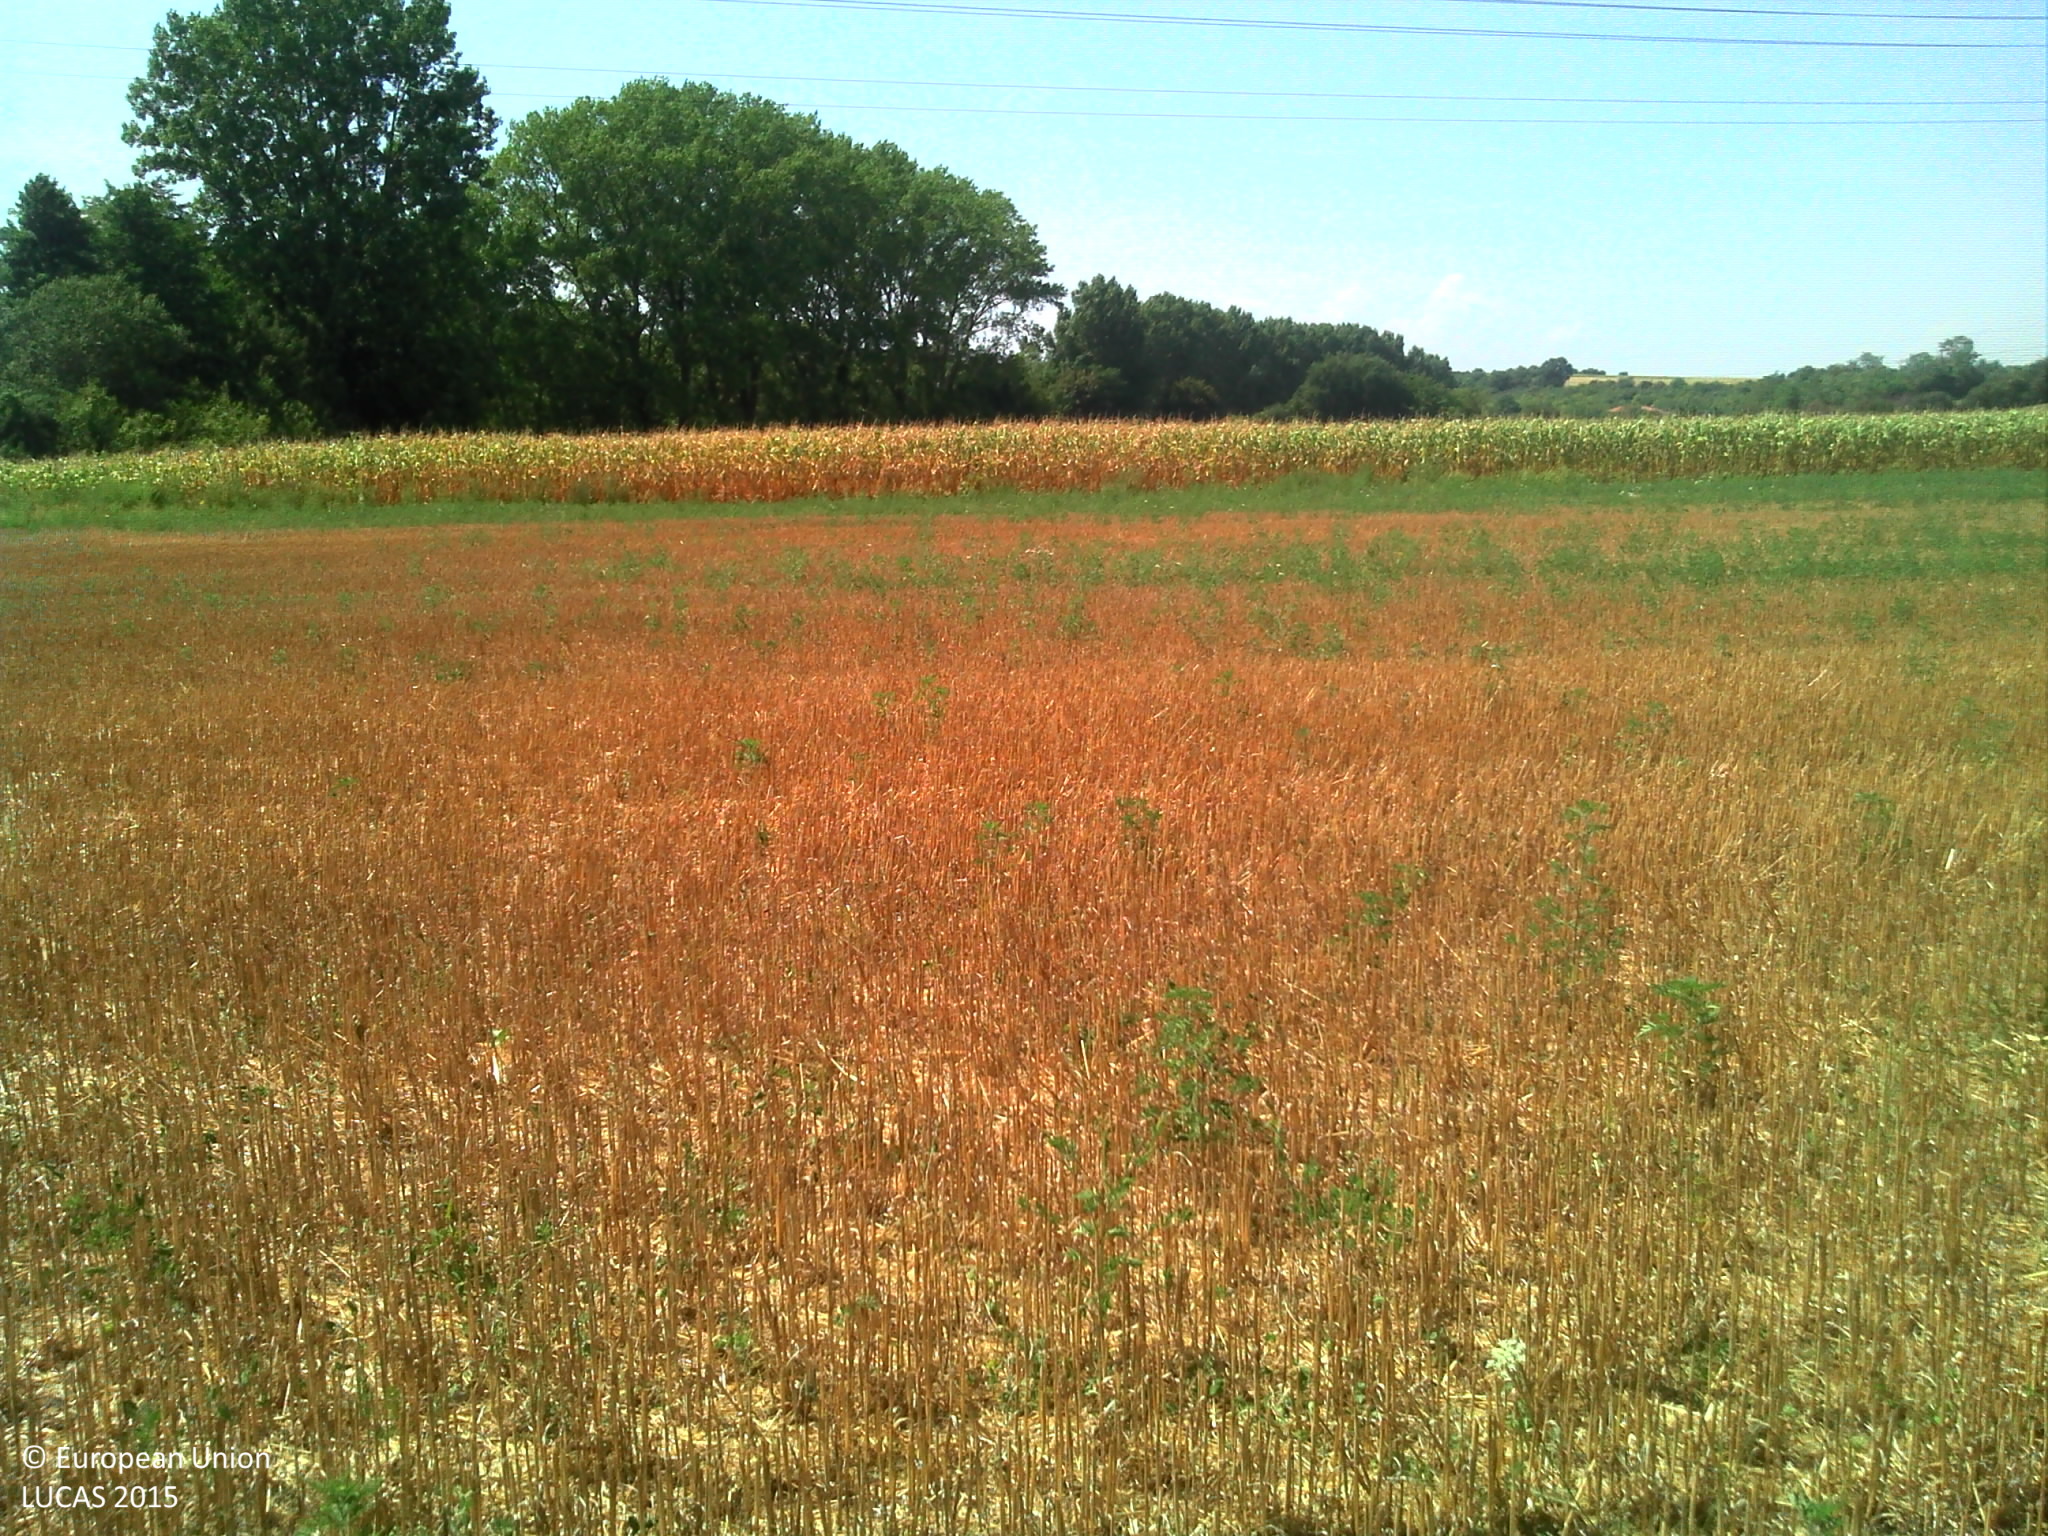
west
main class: Cropland
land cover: Durum wheat
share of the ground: > 75 %
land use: Agriculture (excluding fallow land and kitchen gardens)
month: August
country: FR
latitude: 45.6369
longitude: 4.9623
